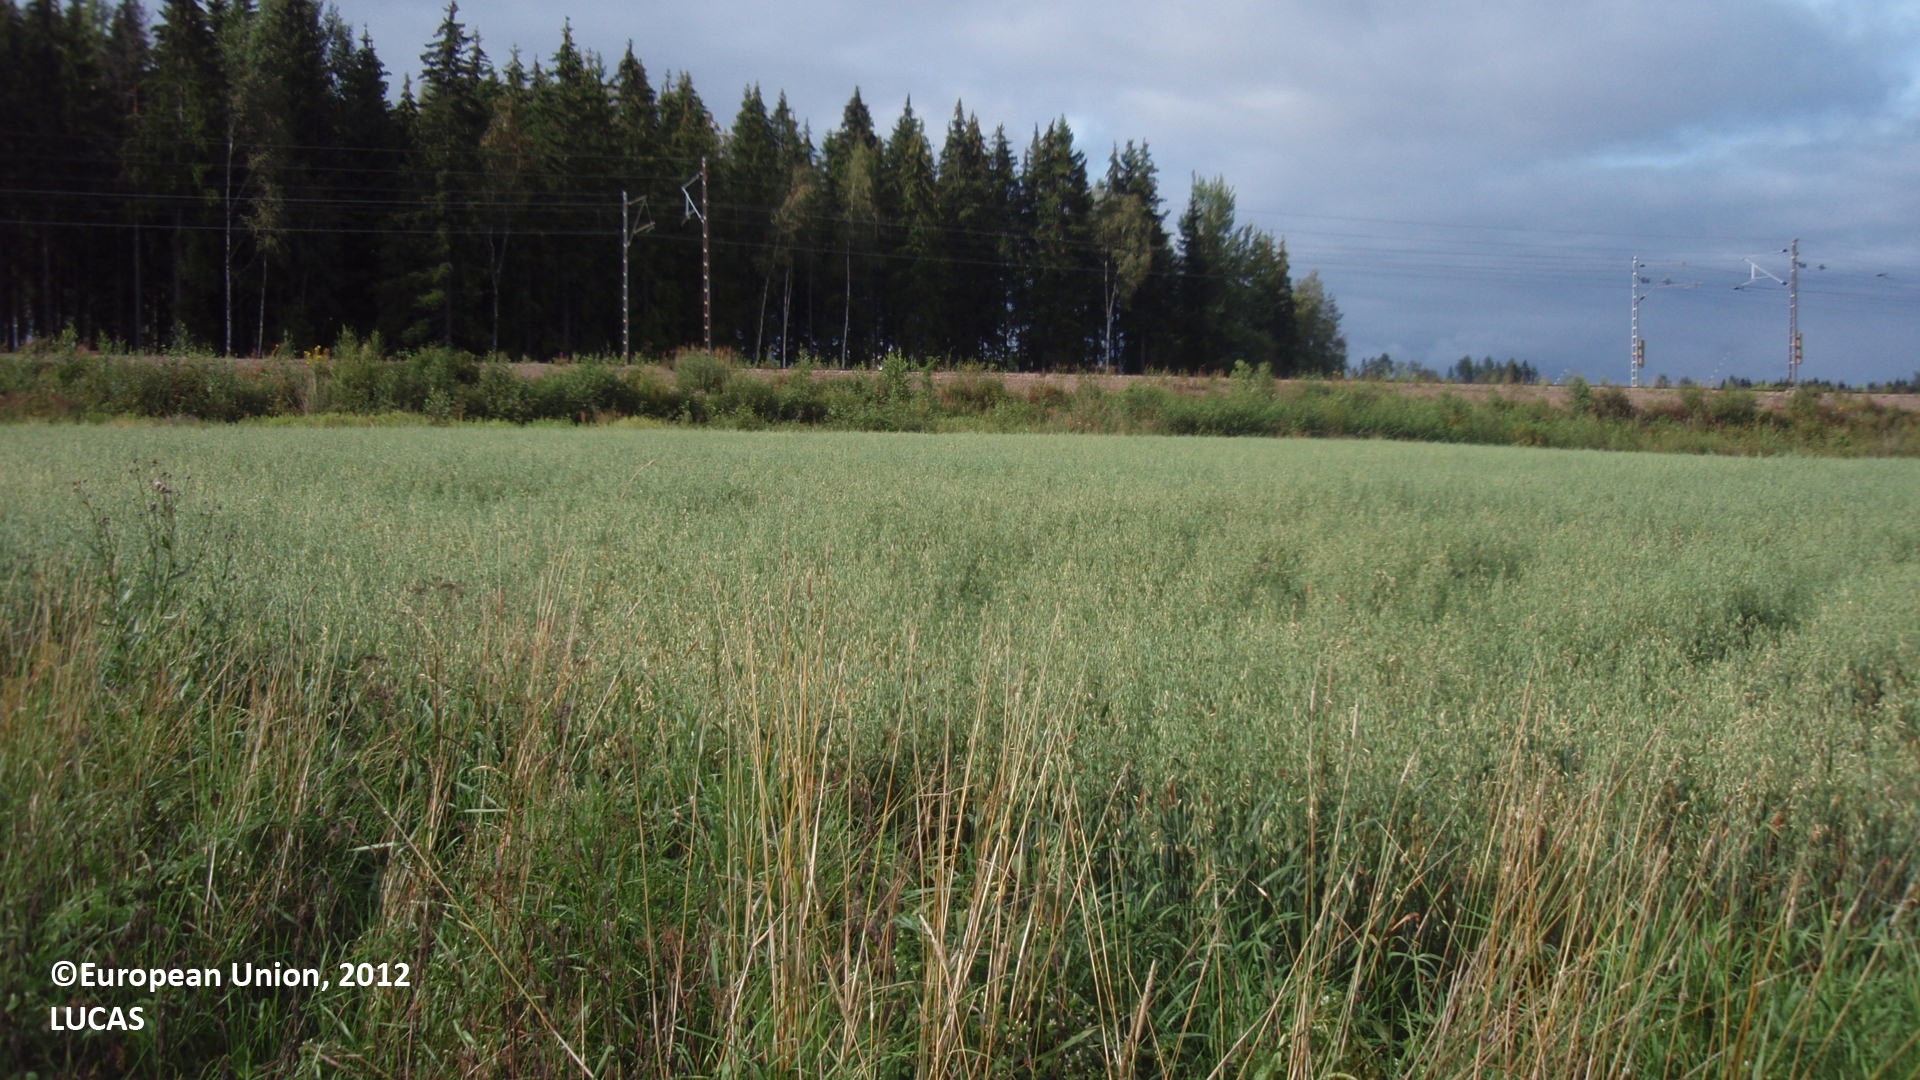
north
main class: Cropland
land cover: Rape and turnip rape
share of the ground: > 75 %
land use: Agriculture (excluding fallow land and kitchen gardens)
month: August
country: FI
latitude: 60.9110
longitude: 27.6119
